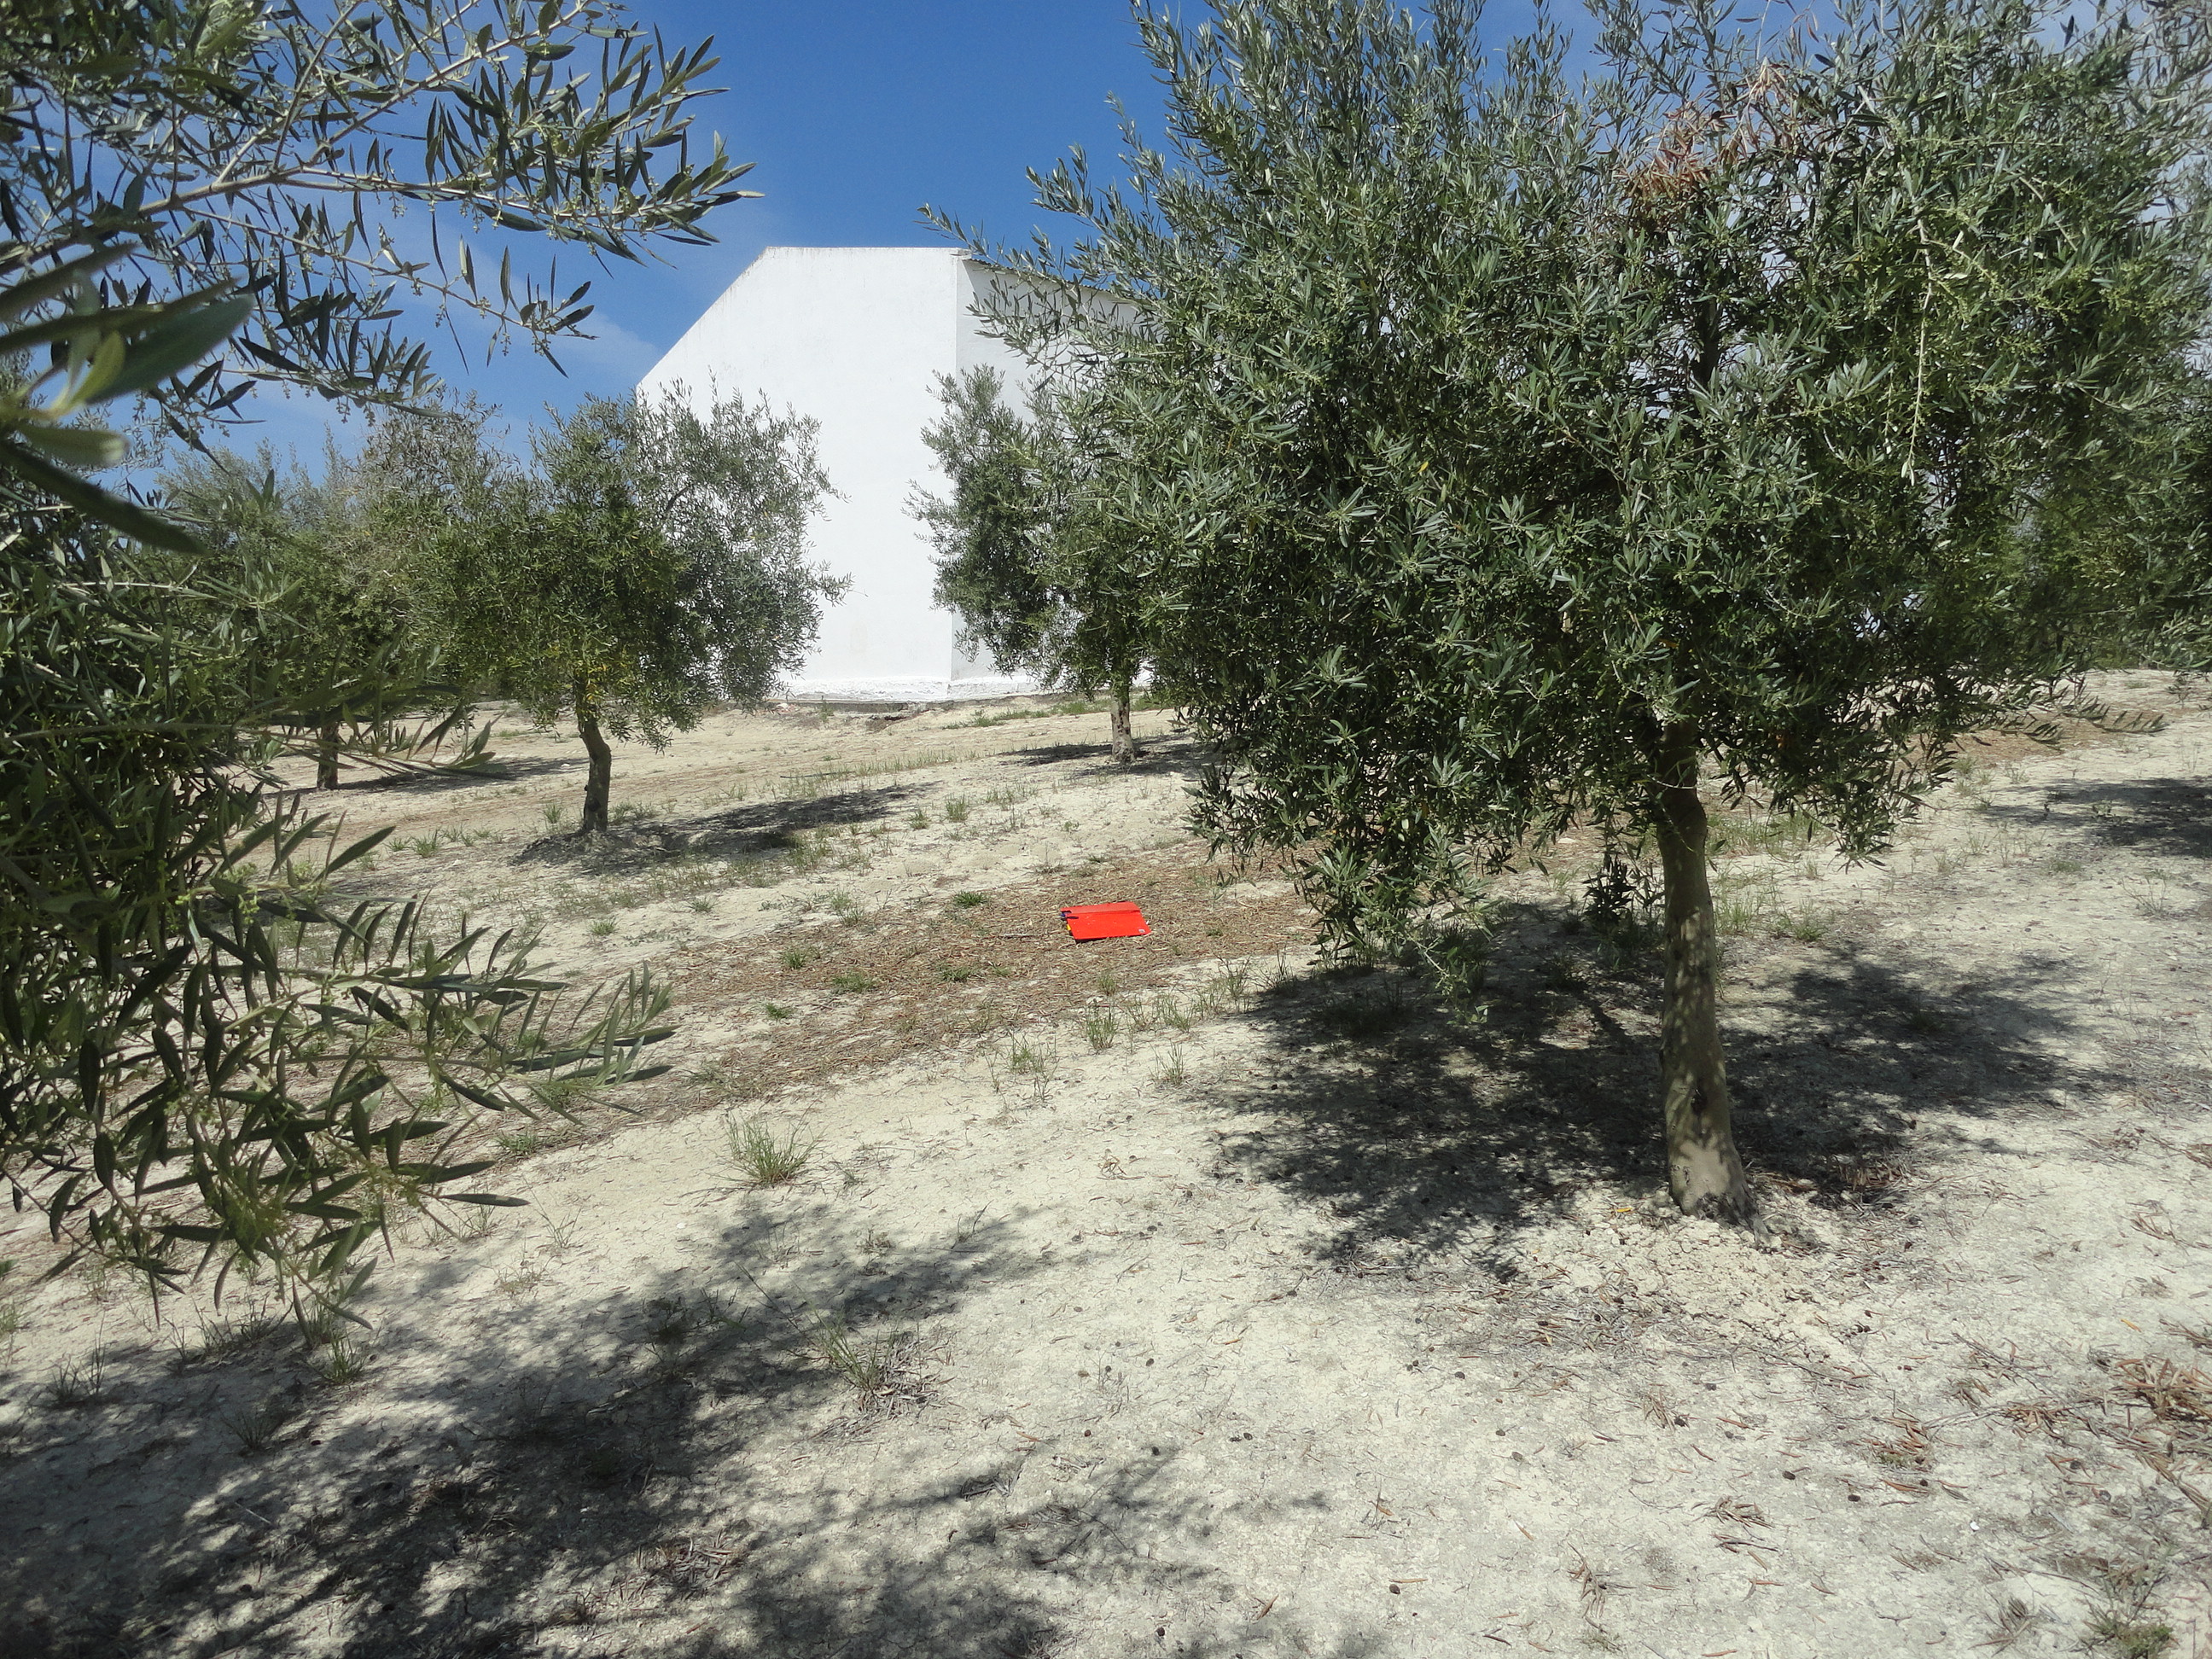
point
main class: Cropland
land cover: Olive groves
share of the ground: 50 - 75 %
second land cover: Spontaneously vegetated surfaces
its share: 10 - 25 %
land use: Agriculture (excluding fallow land and kitchen gardens)
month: April
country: ES
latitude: 37.6189
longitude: -4.4050
